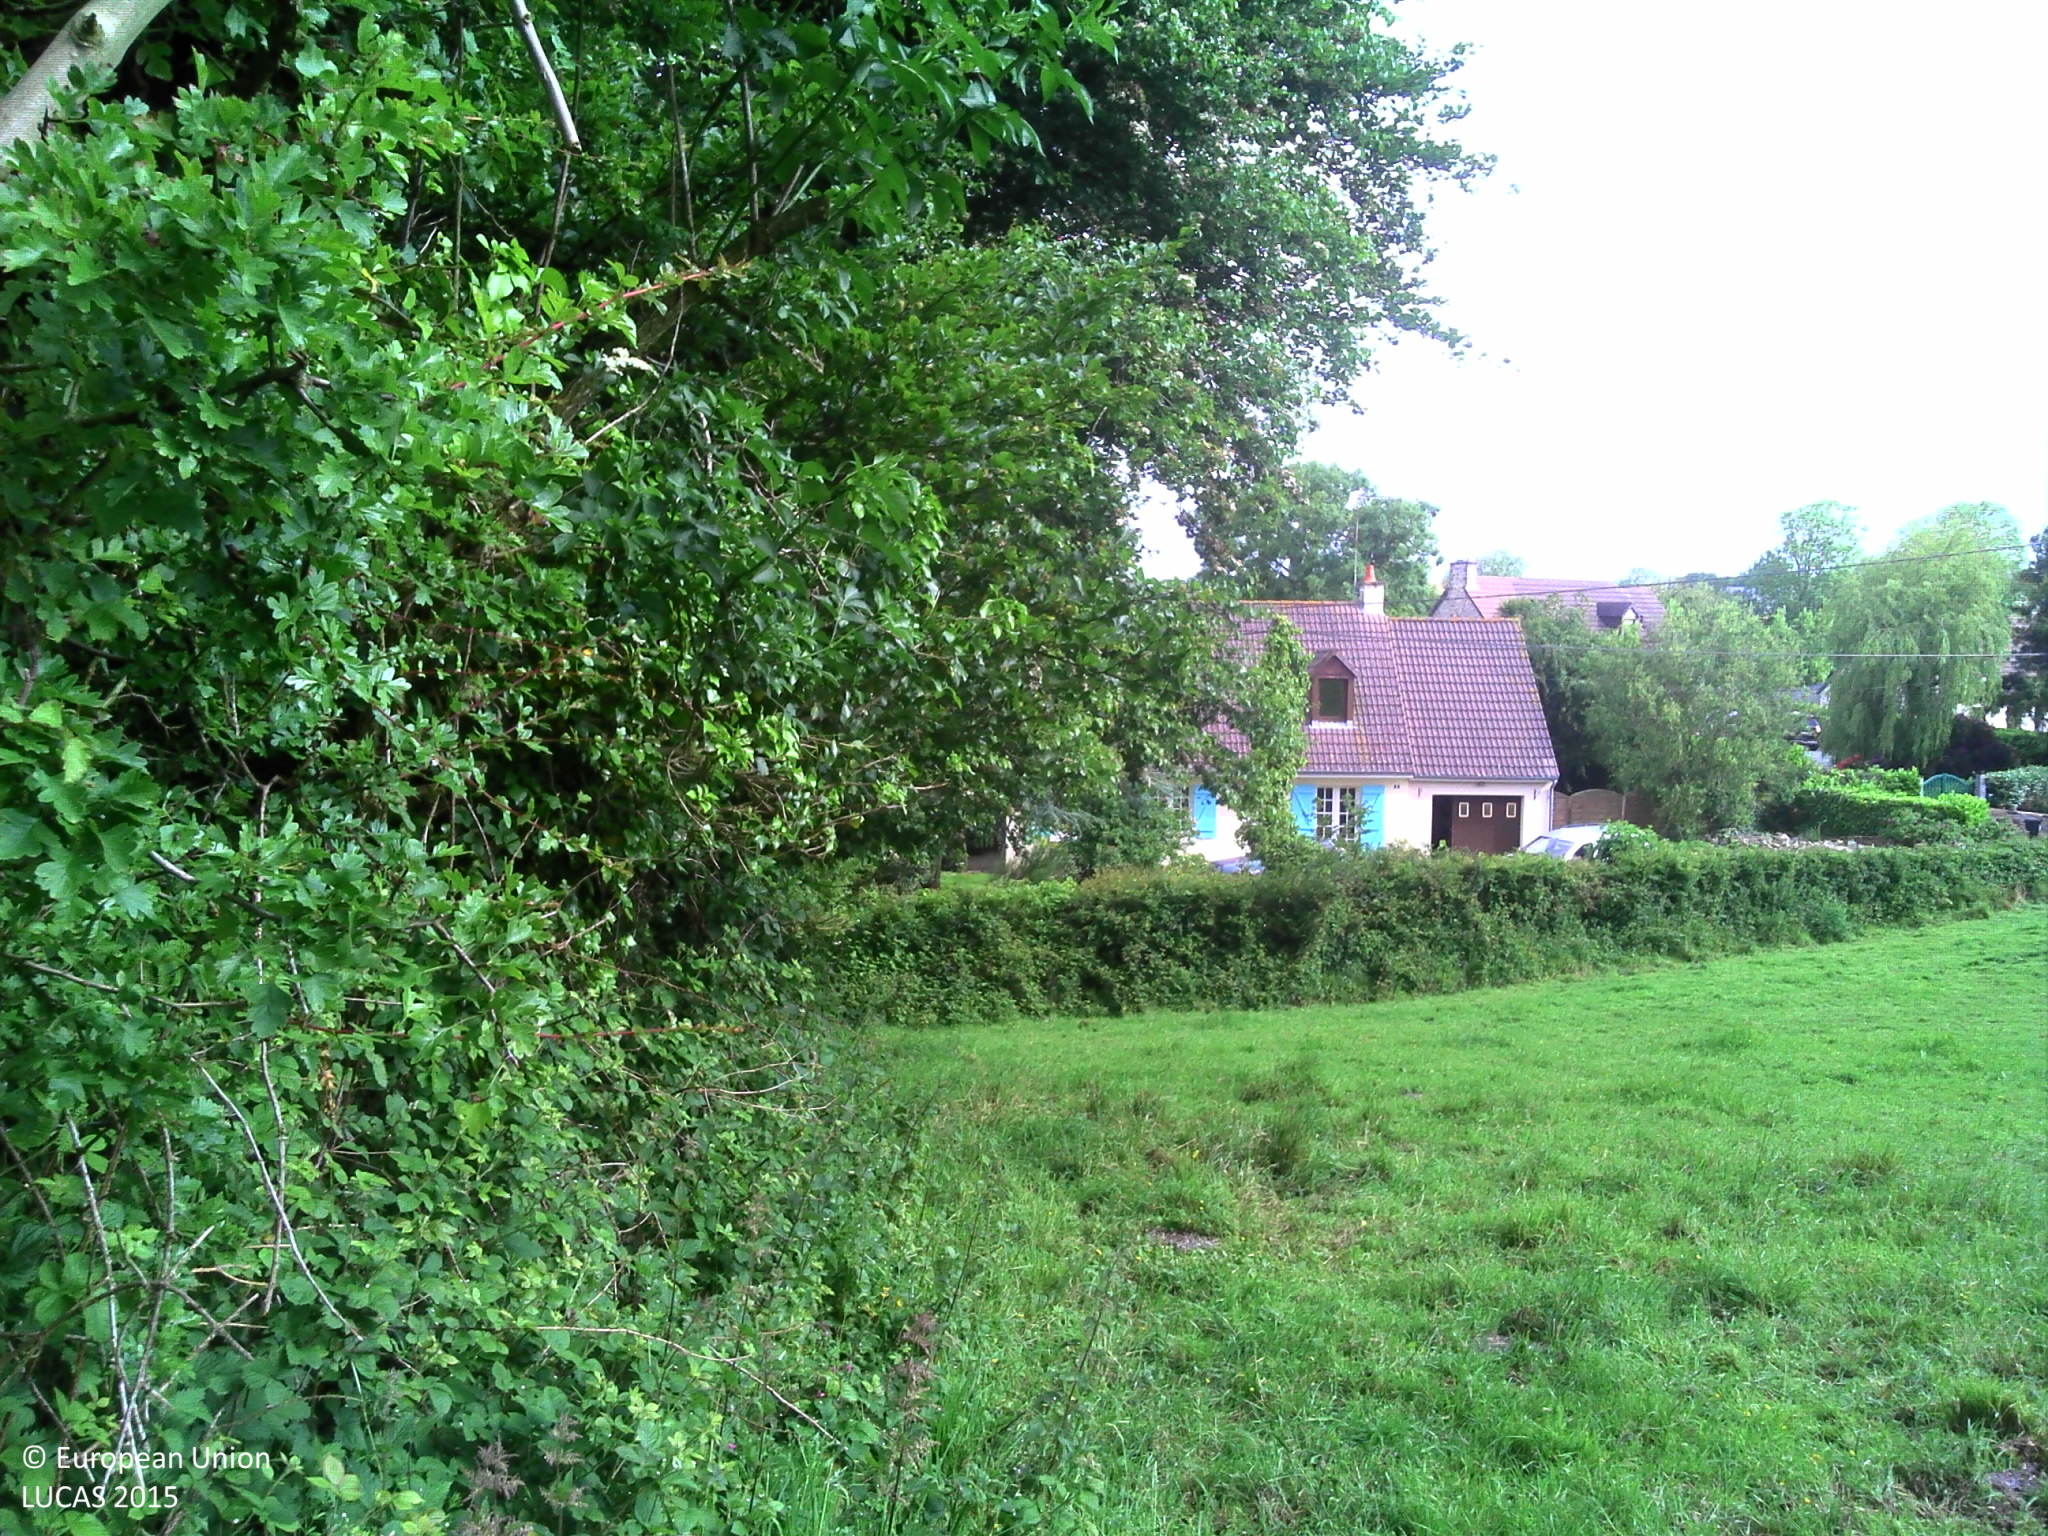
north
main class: Grassland
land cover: Grassland without tree/shrub cover
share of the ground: > 75 %
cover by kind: herbaceous plants 100 %
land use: Agriculture (excluding fallow land and kitchen gardens)
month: June
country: FR
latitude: 49.5519
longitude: -1.7890
